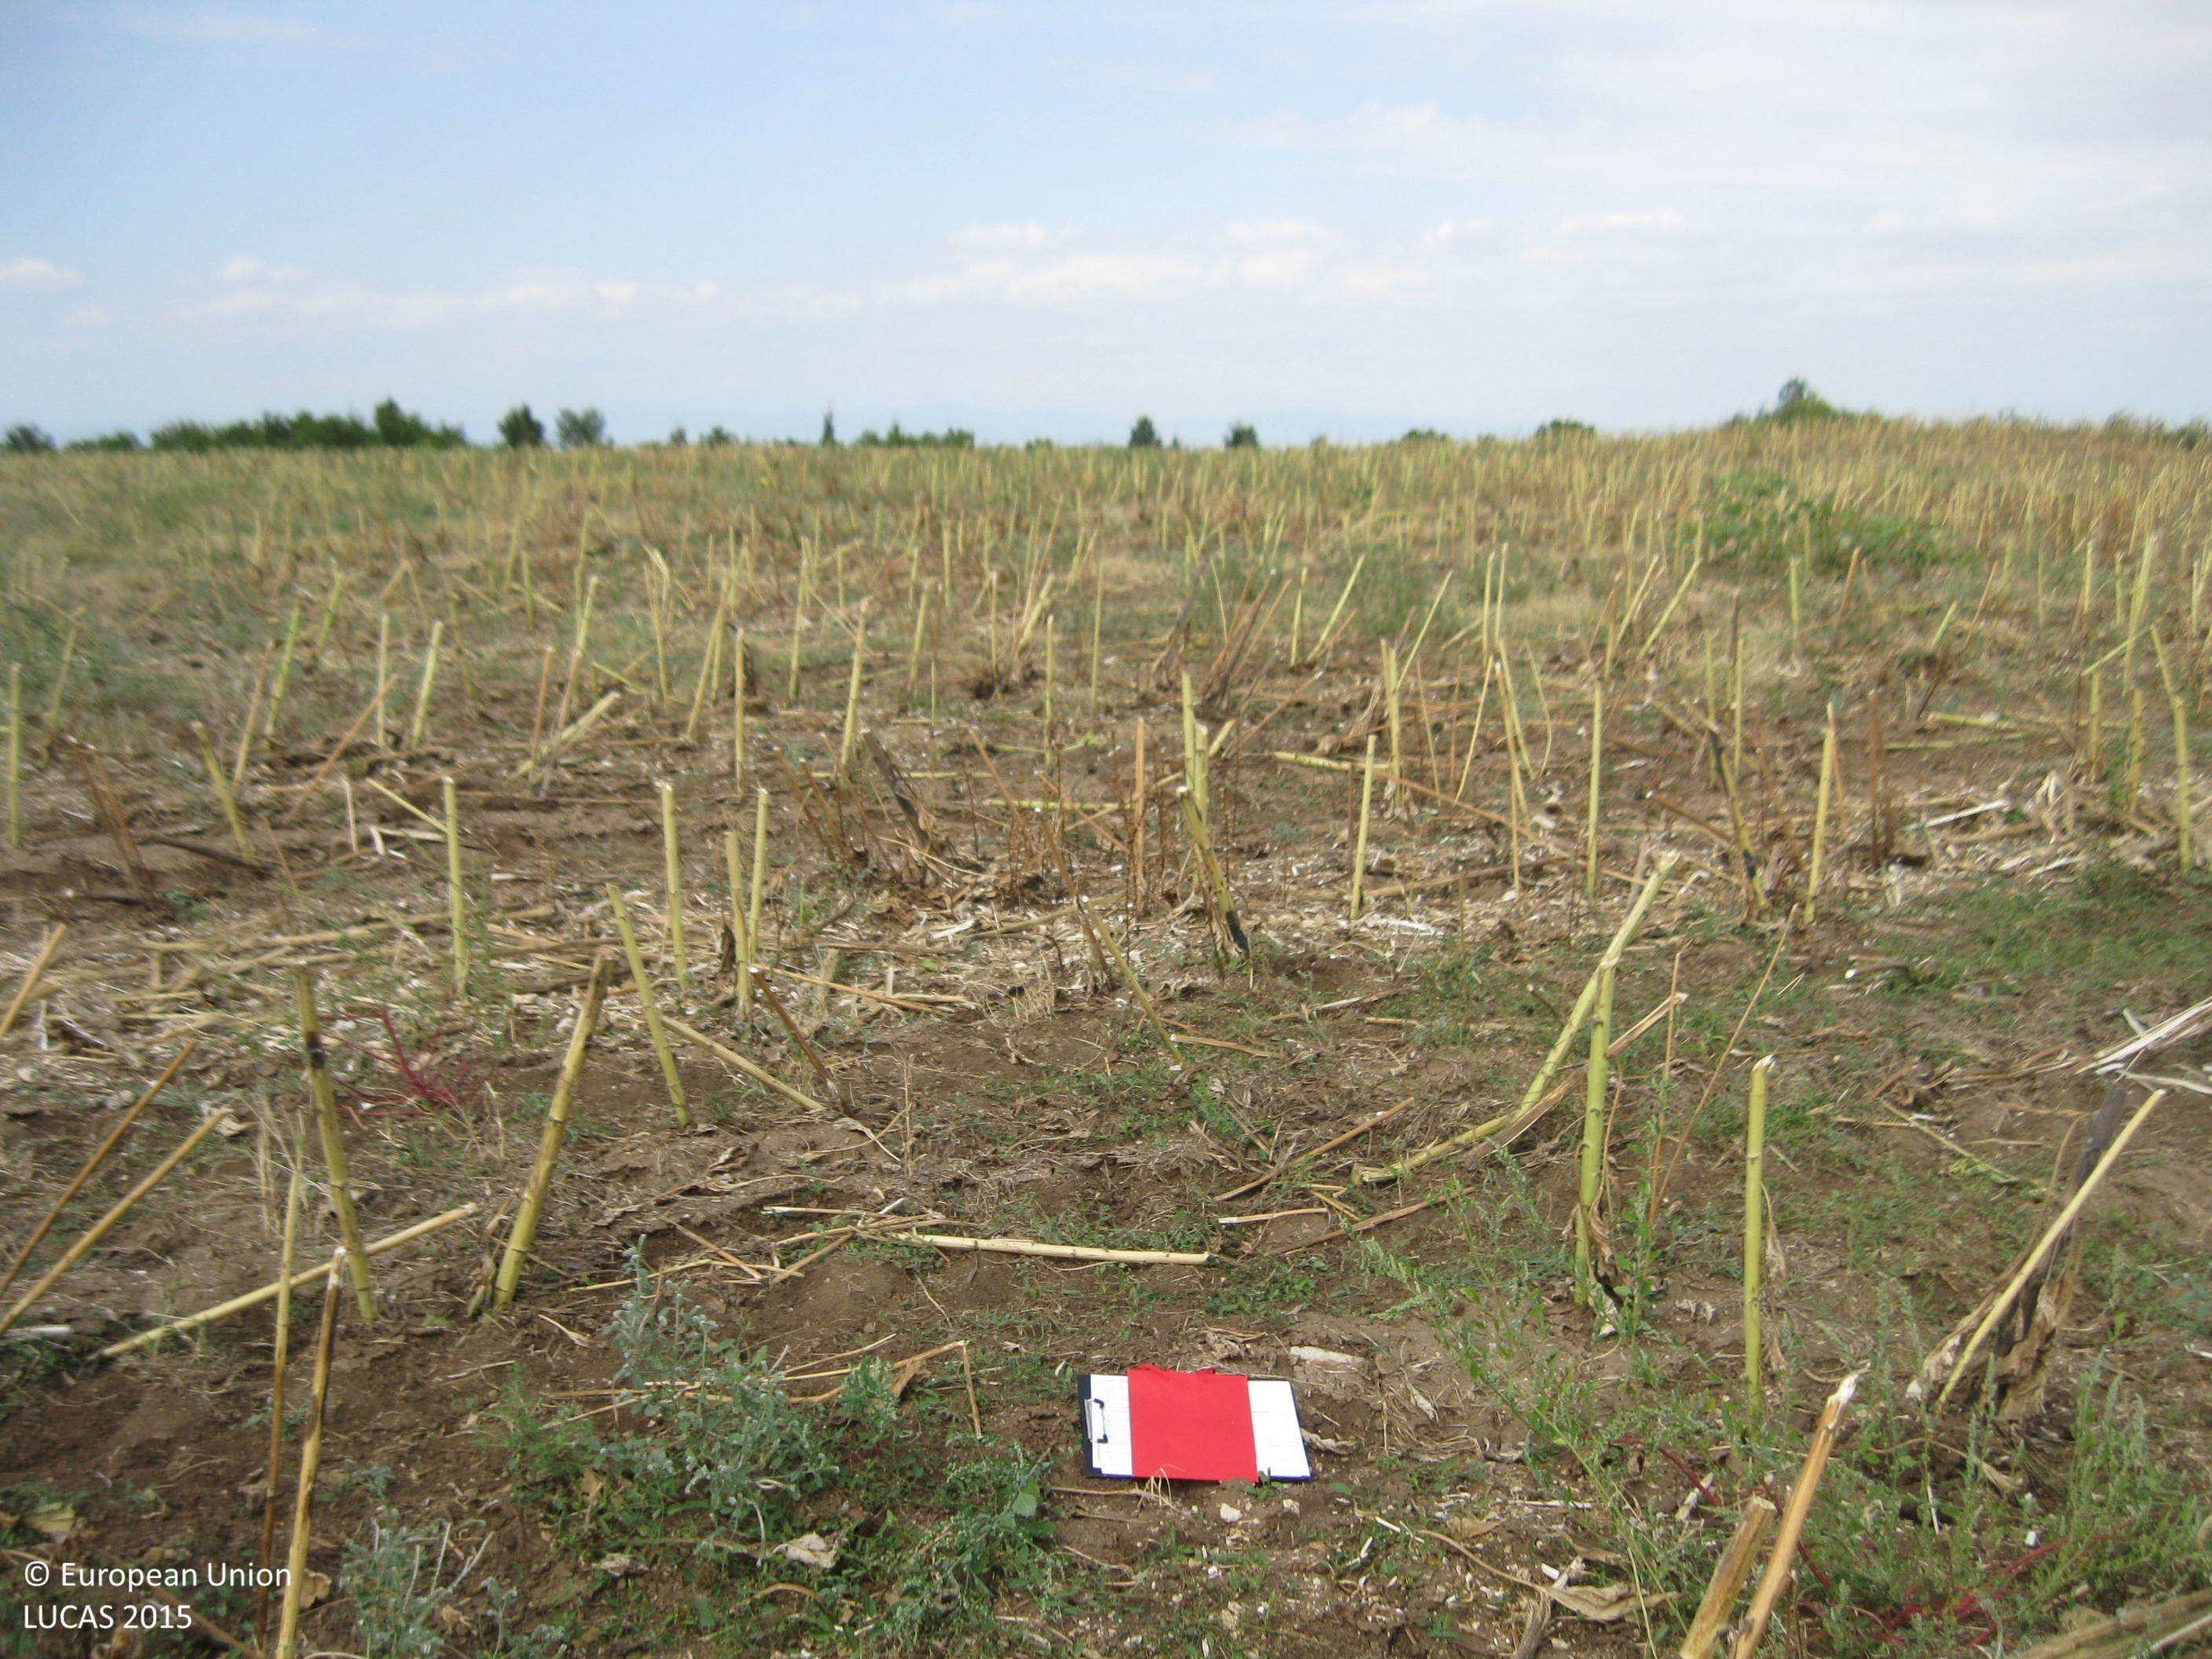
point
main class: Cropland
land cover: Sunflower
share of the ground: < 10 %
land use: Agriculture (excluding fallow land and kitchen gardens)
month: September
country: BG
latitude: 42.0996
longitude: 25.1117
